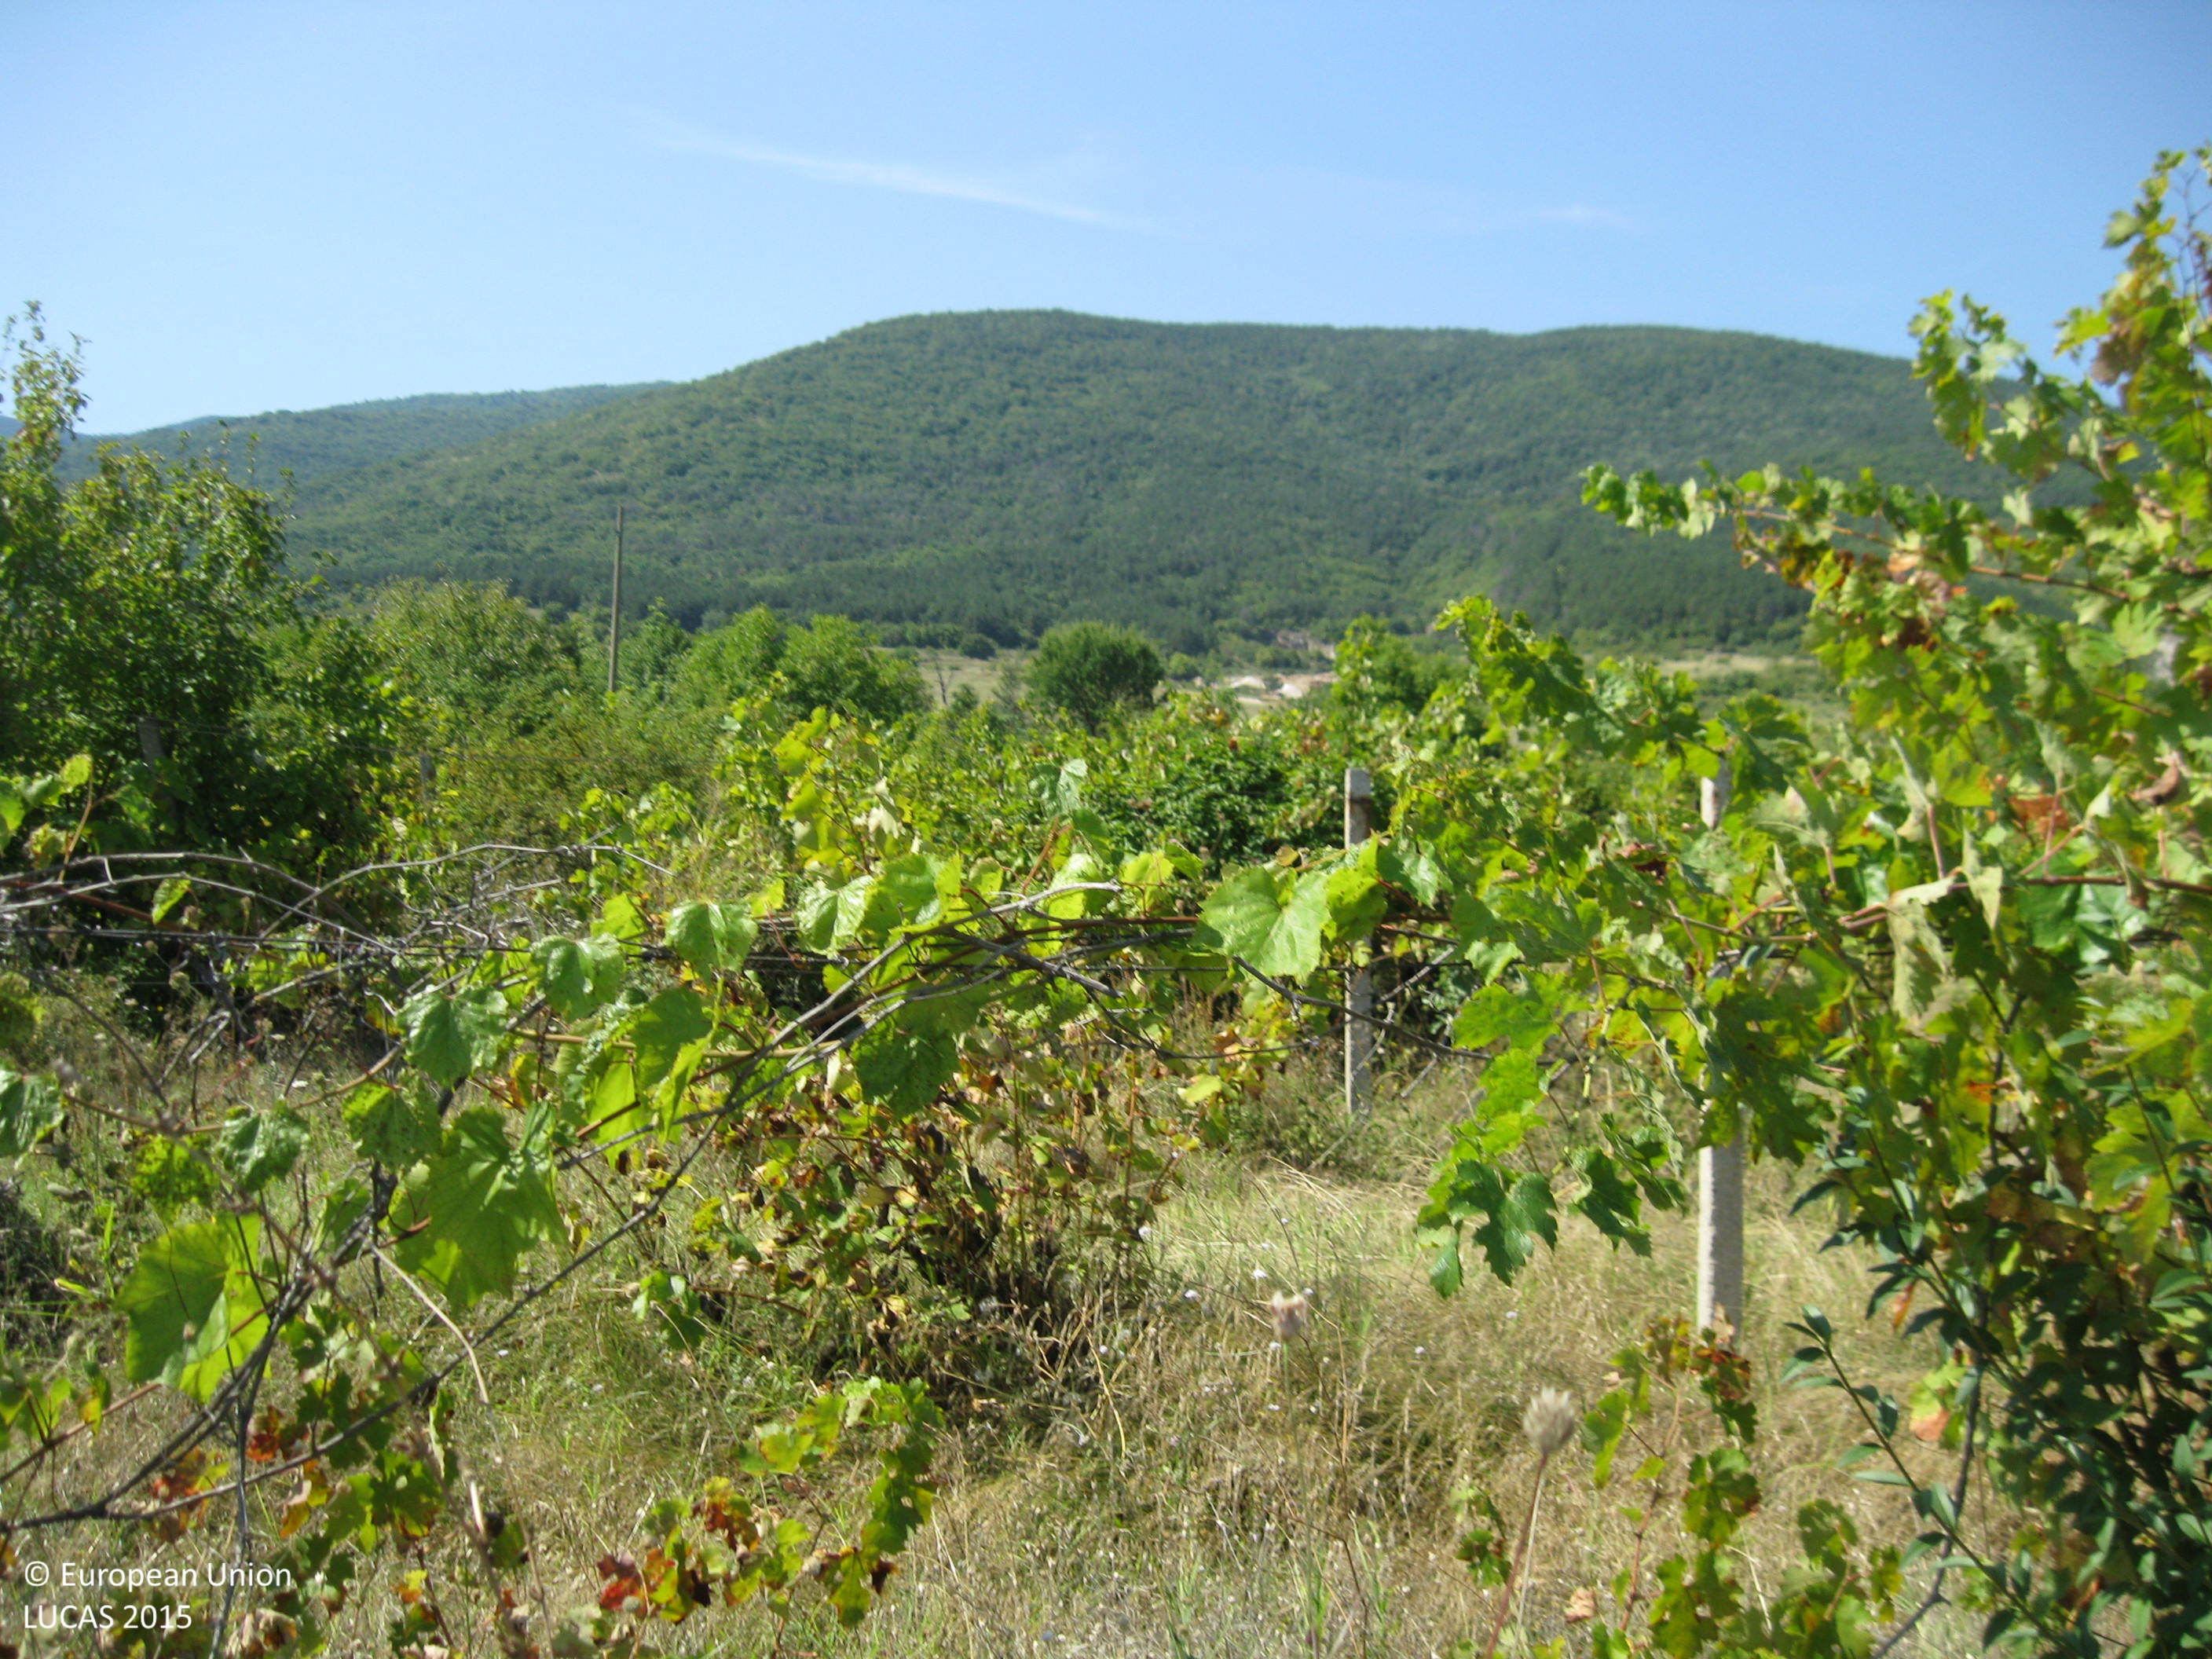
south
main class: Cropland
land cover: Vineyards
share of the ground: 25 - 50 %
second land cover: Spontaneously vegetated surfaces
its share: > 75 %
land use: Agriculture (excluding fallow land and kitchen gardens)
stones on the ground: < 10 %
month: August
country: BG
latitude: 41.9798
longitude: 24.9339
